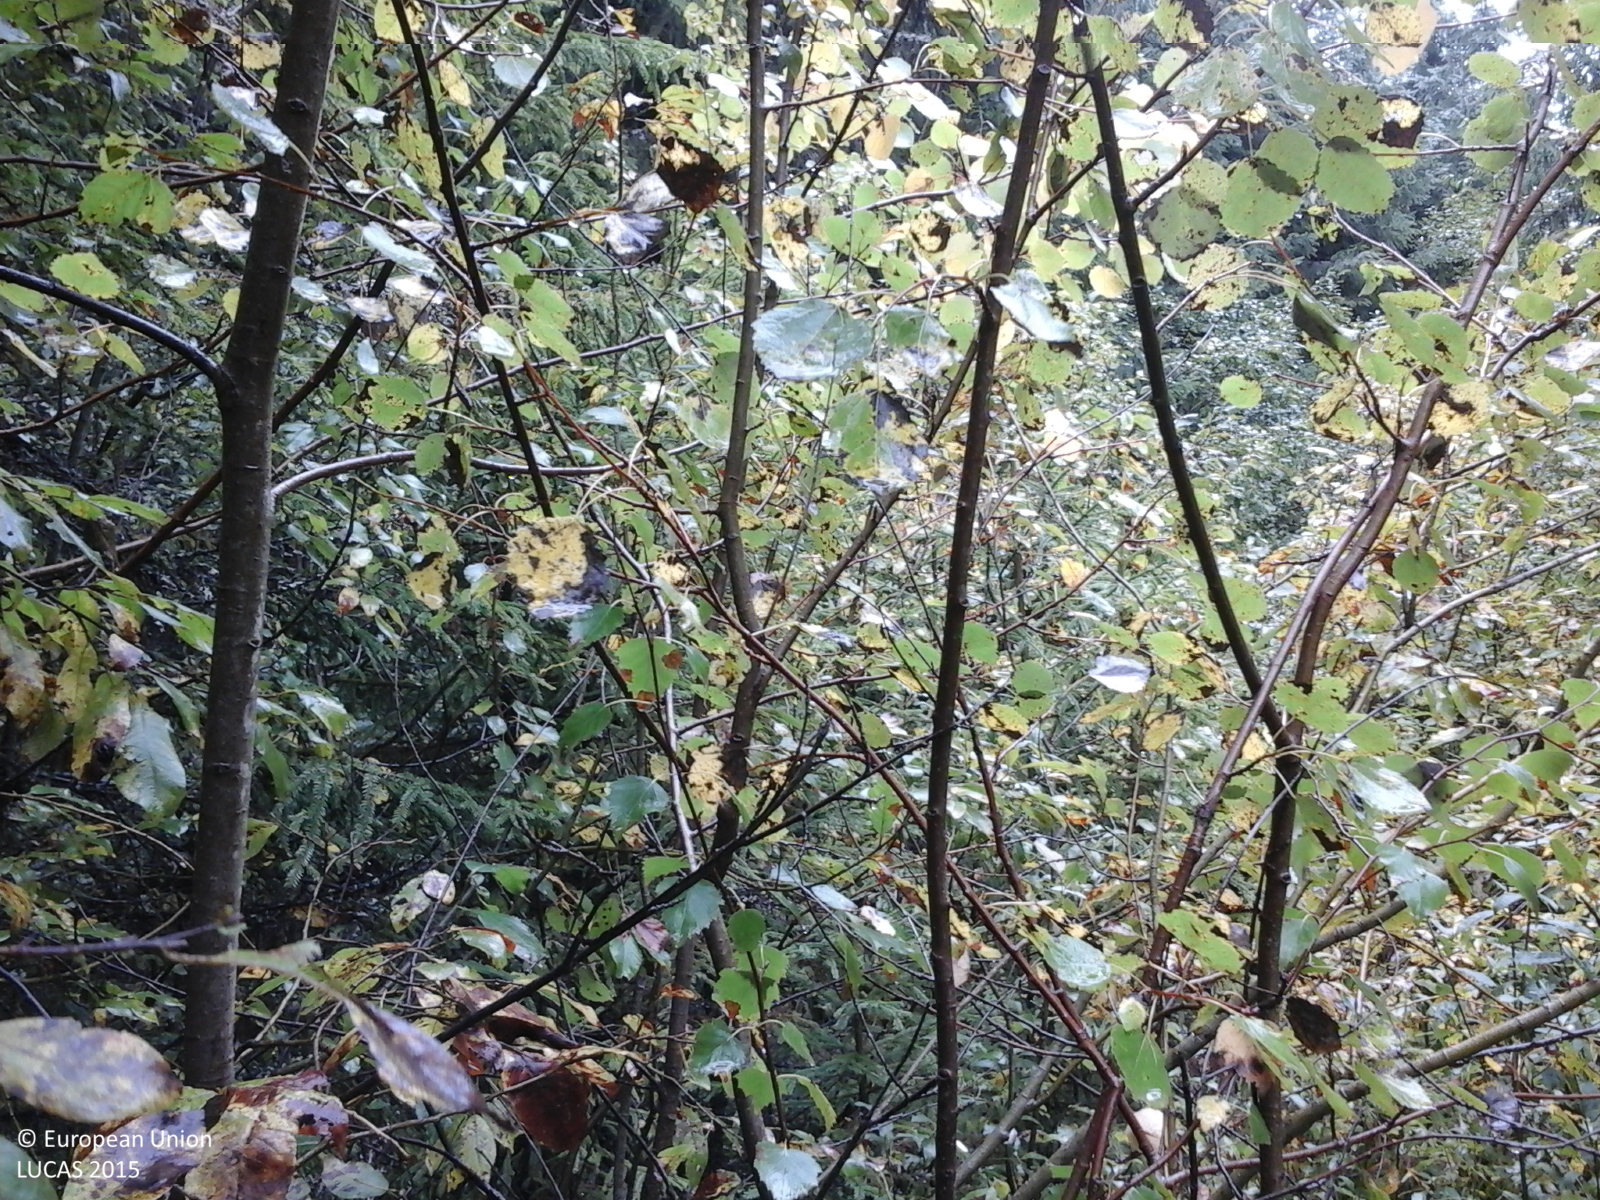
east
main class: Woodland
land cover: Spruce dominated coniferous woodland
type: alpine coniferous forest
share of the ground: > 75 %
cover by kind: coniferous forest trees 90 %, shrubs 5 %, herbaceous plants 5 %
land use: Forestry
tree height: > 5 m
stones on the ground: 10 - 25 %
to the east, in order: Spruce dominated coniferous woodland; Spruce dominated mixed woodland; Paved roads, cycling and walking lanes; Spruce dominated coniferous woodland; Shrubland with sparse tree cover; Tracks
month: September
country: RO
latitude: 45.5858
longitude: 23.6112
